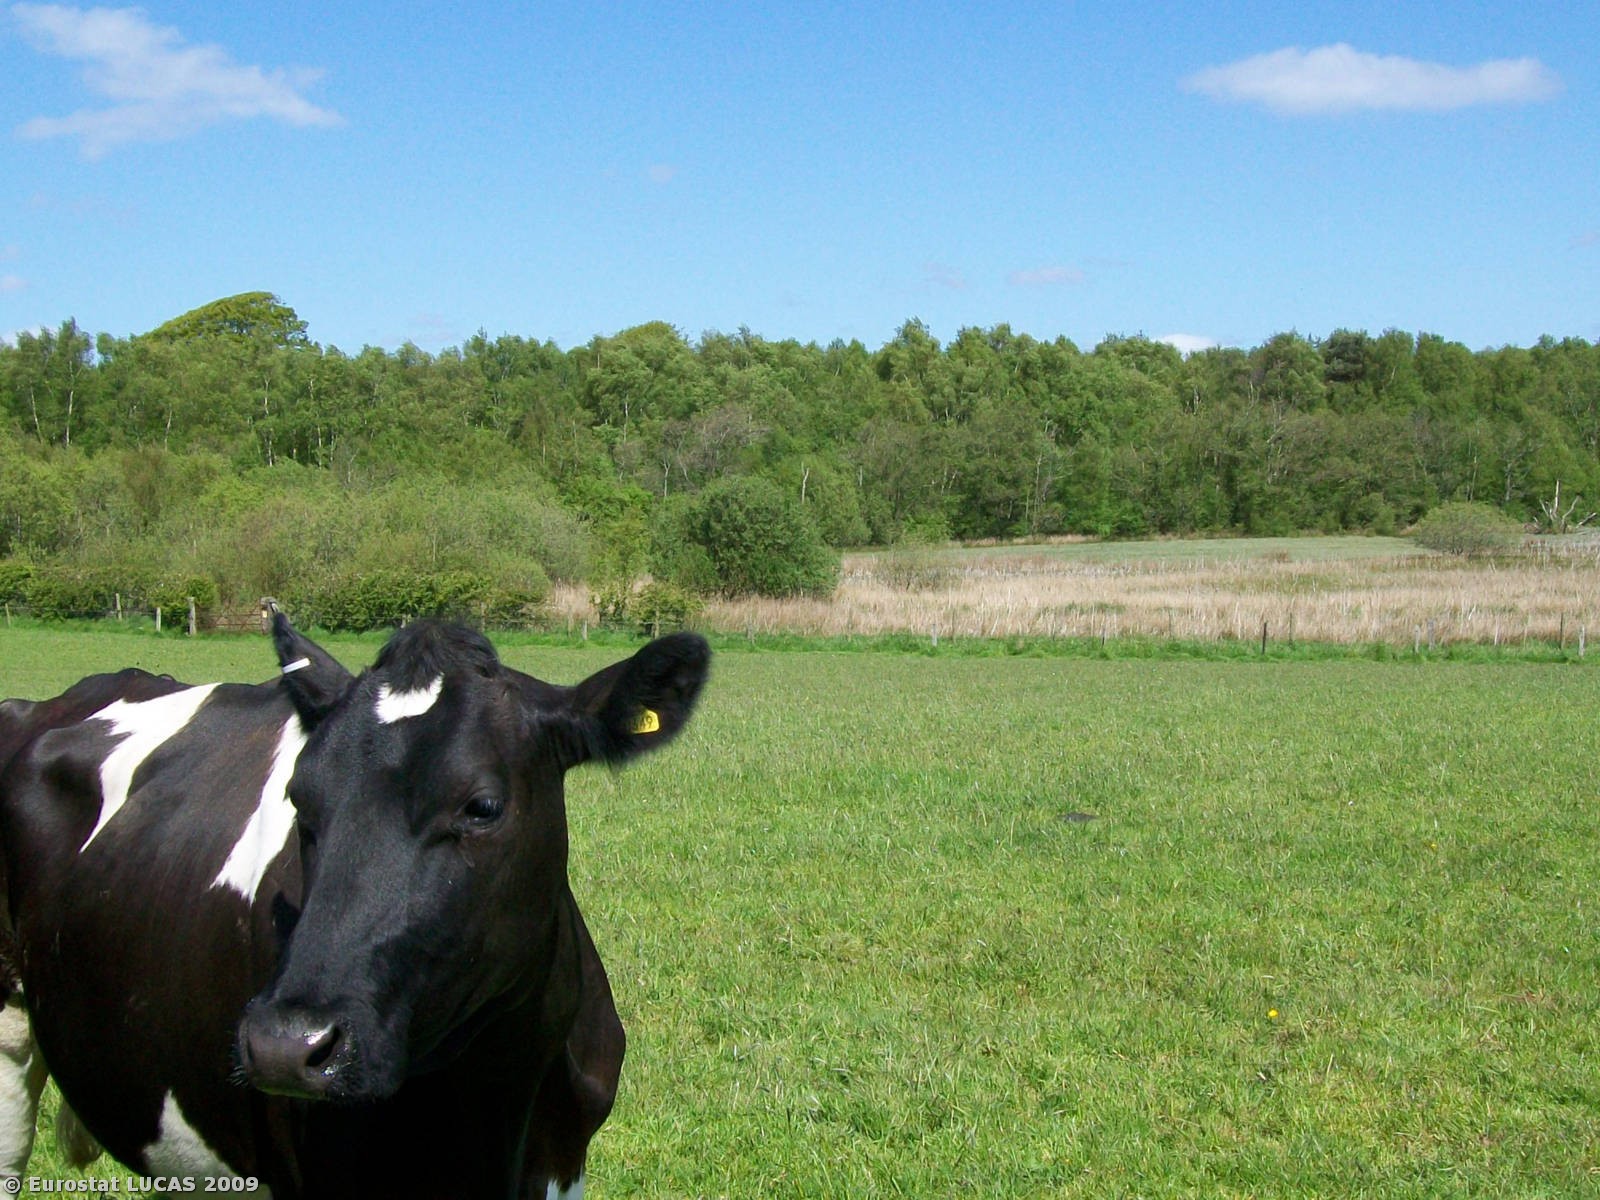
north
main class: Grassland
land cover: Grassland without tree/shrub cover
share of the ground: > 75 %
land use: Agriculture (excluding fallow land and kitchen gardens)
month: May
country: GB
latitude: 54.7788
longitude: -3.3084
